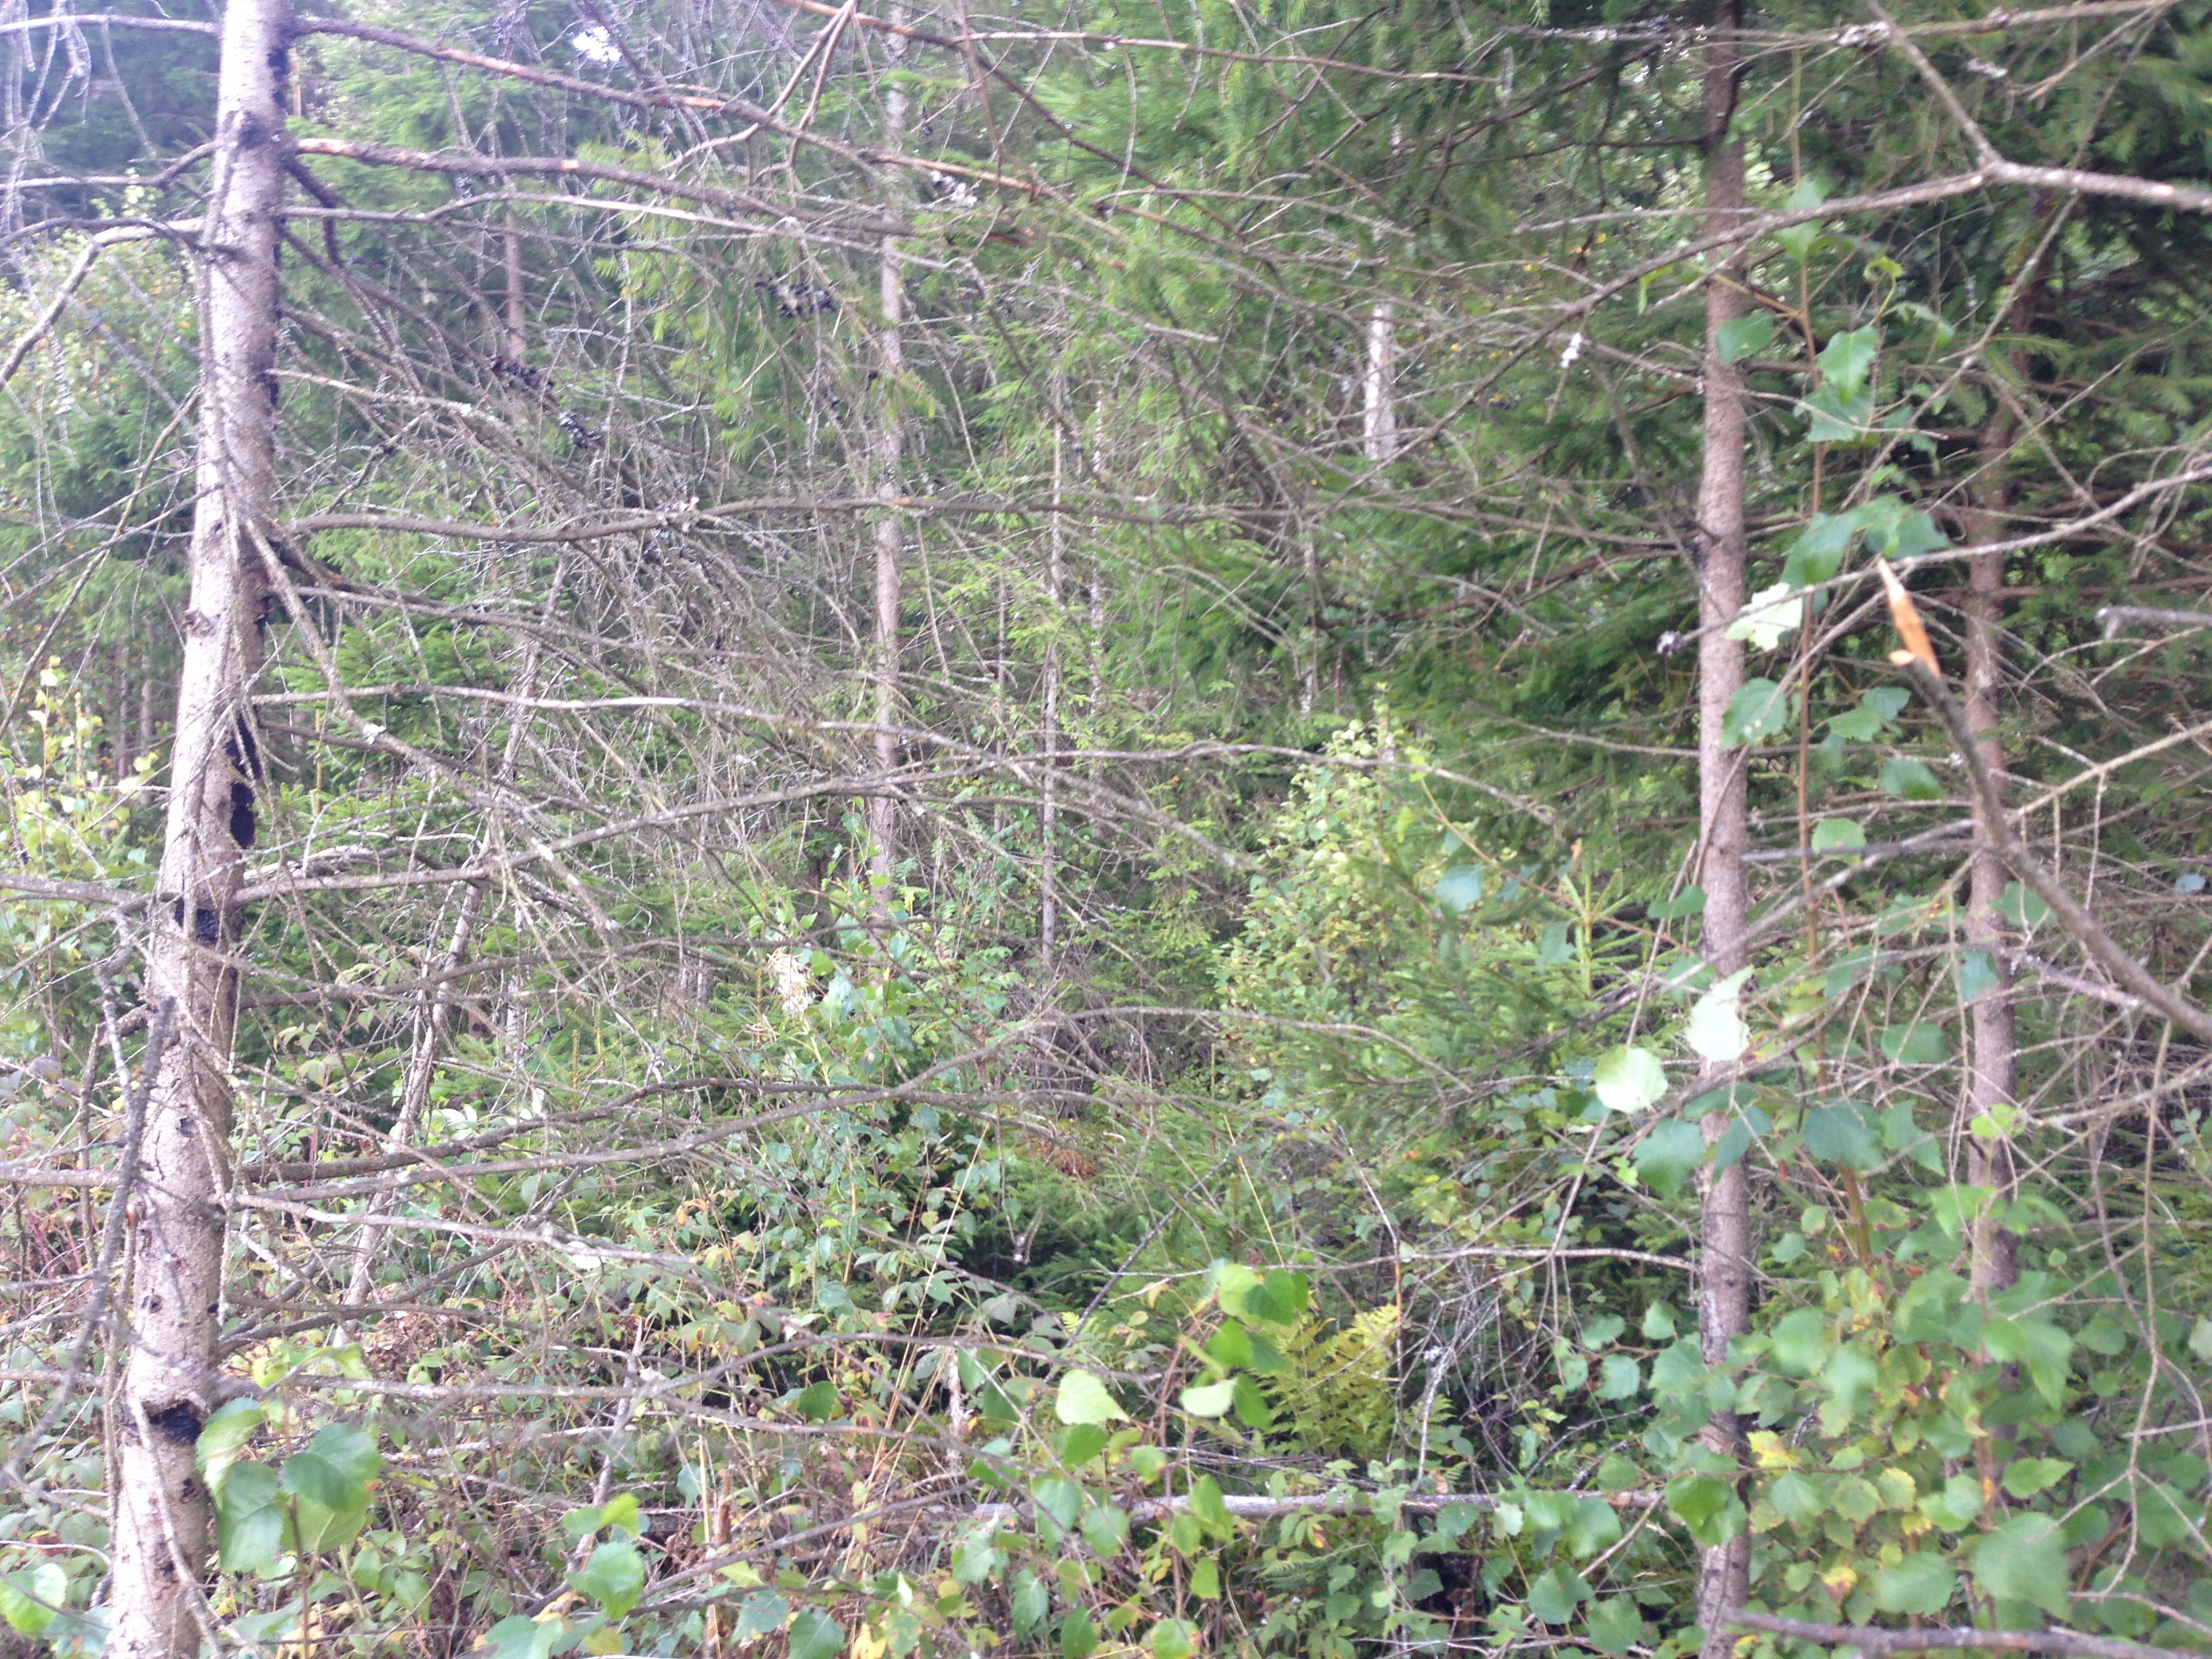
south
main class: Woodland
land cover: Spruce dominated mixed woodland
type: boreal forest
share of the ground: 50 - 75 %
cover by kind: broadleaved forest trees 40 %, coniferous forest trees 25 %, shrubs 25 %, herbaceous plants 10 %
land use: Forestry
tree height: < 5 m
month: September
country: SE
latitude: 57.2448
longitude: 13.2275
